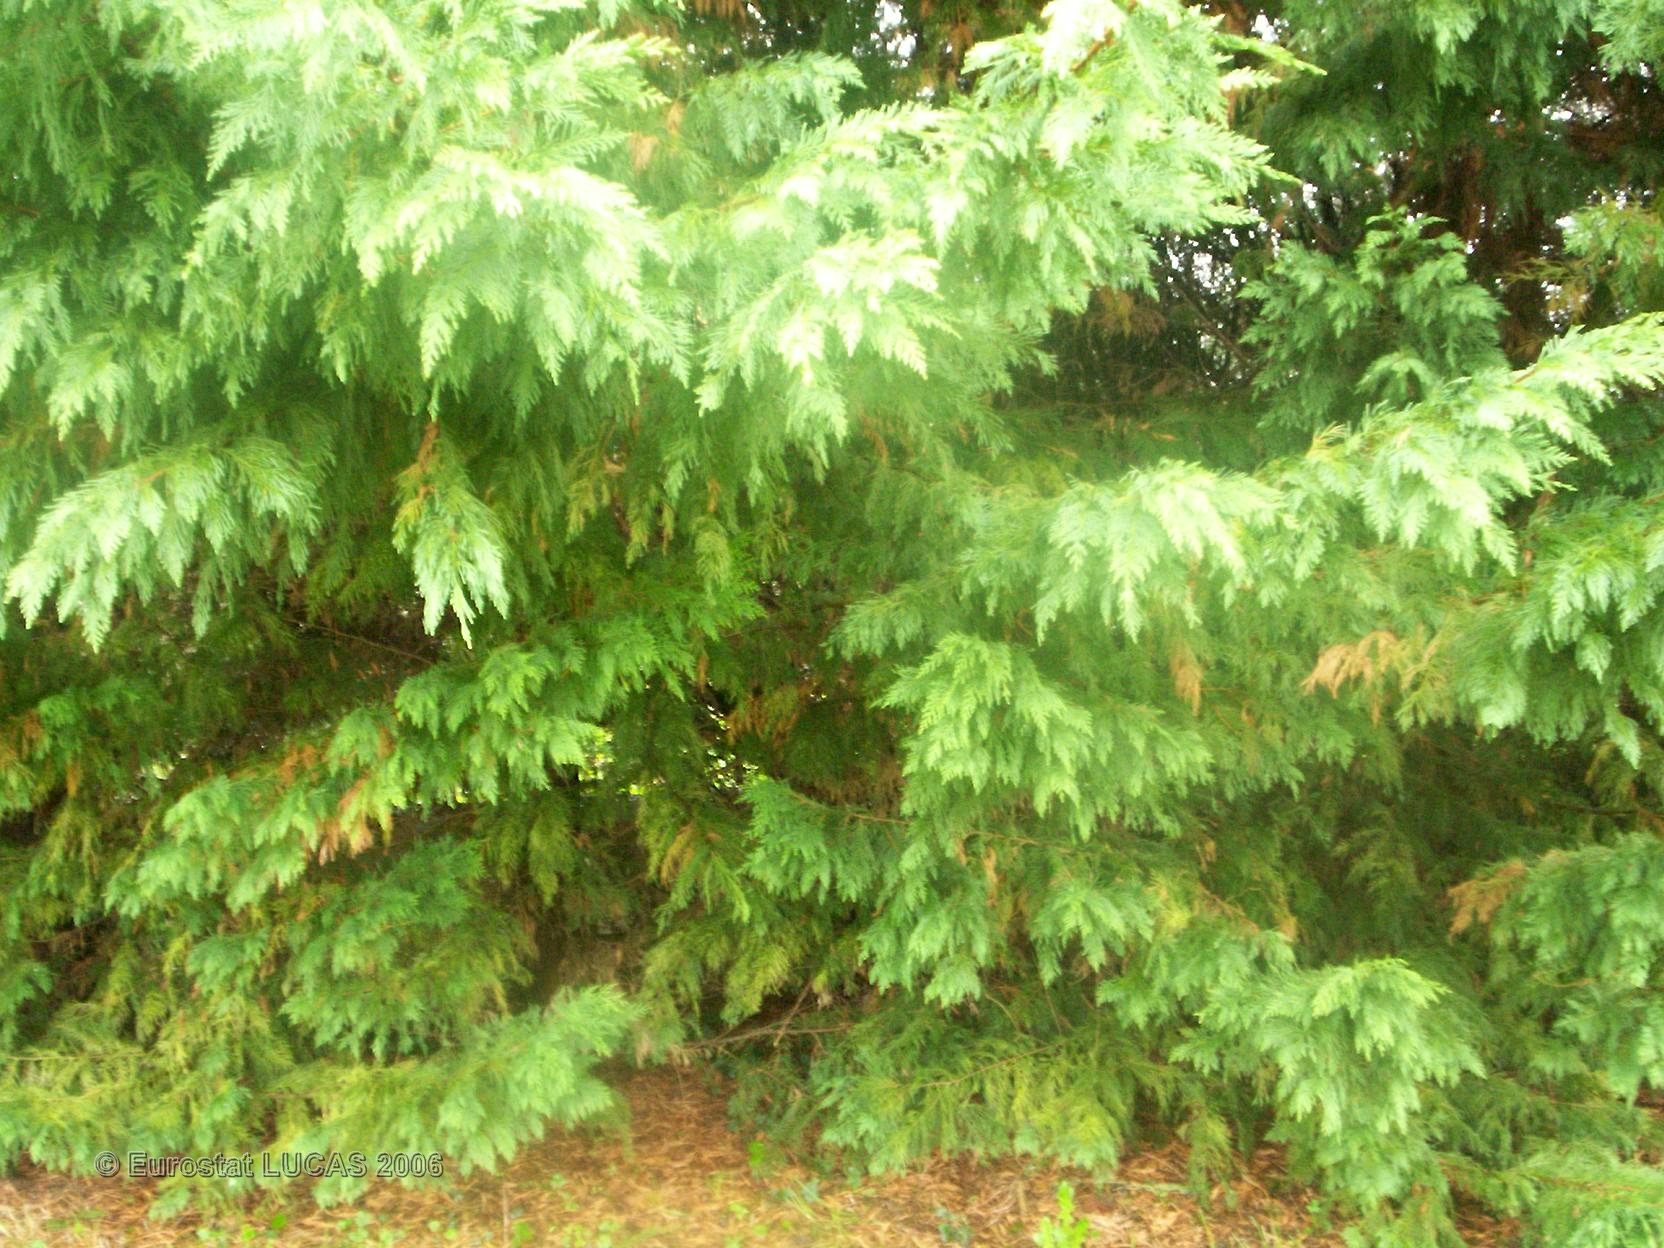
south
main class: Grassland
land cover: Grassland with sparse tree/shrub cover
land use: Residential
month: April
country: FR
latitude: 47.0311
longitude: 3.0876
